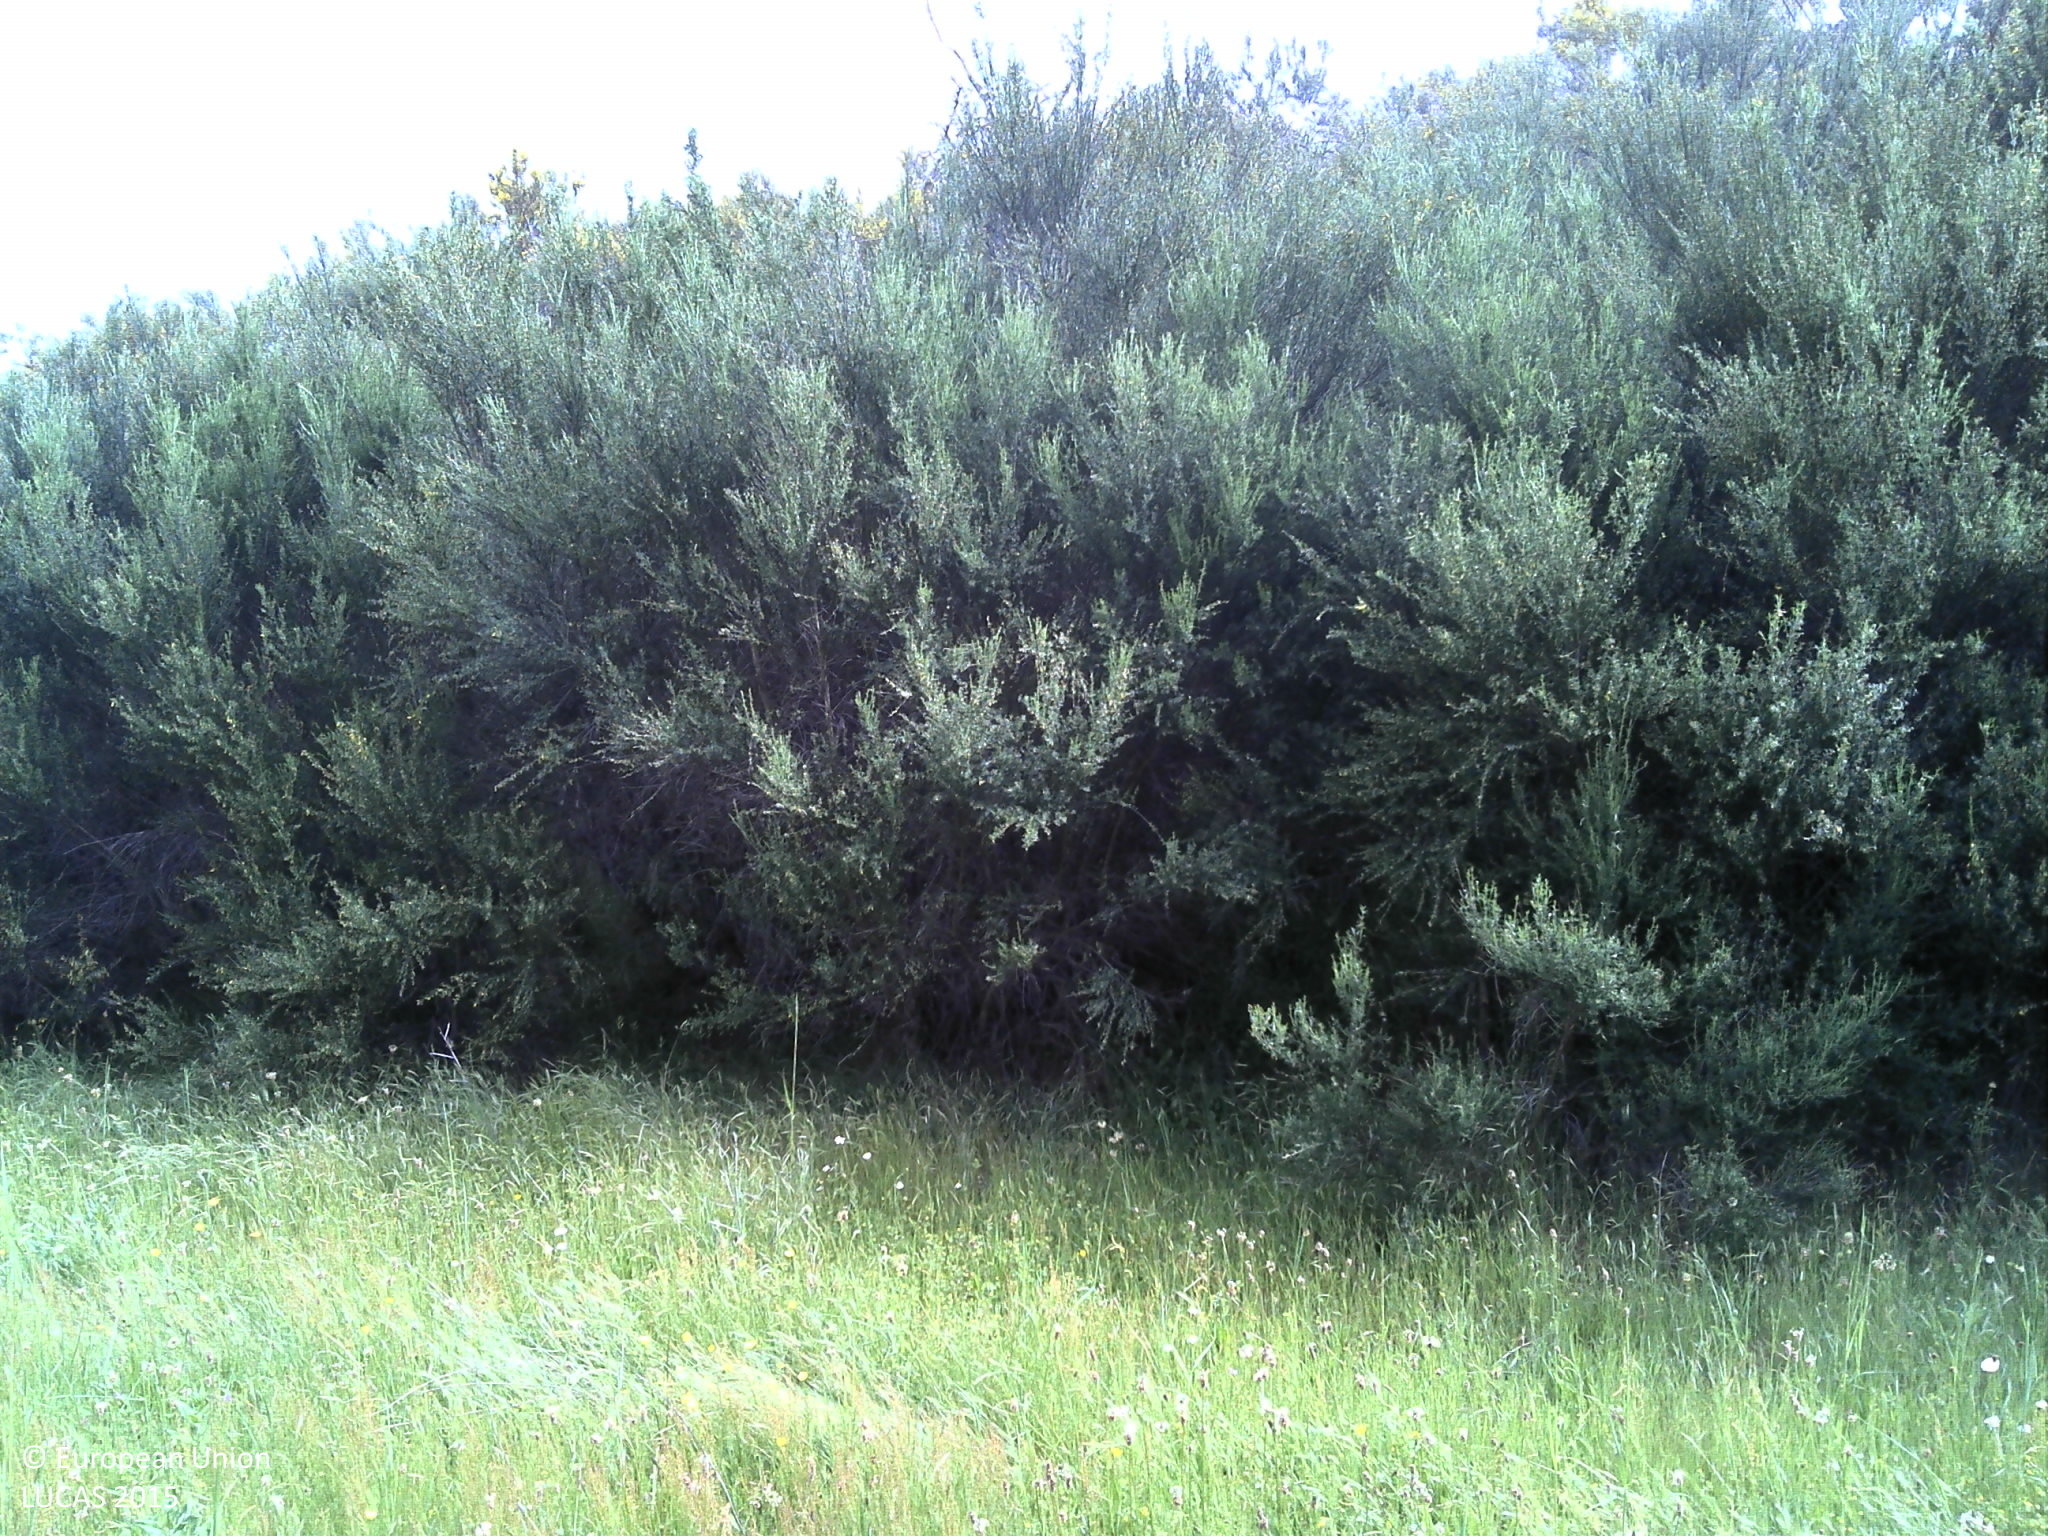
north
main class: Grassland
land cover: Grassland without tree/shrub cover
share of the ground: > 75 %
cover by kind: herbaceous plants 90 %, unconsolidated bare surface 10 %
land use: Agriculture (excluding fallow land and kitchen gardens)
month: May
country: PT
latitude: 41.8338
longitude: -7.0882
